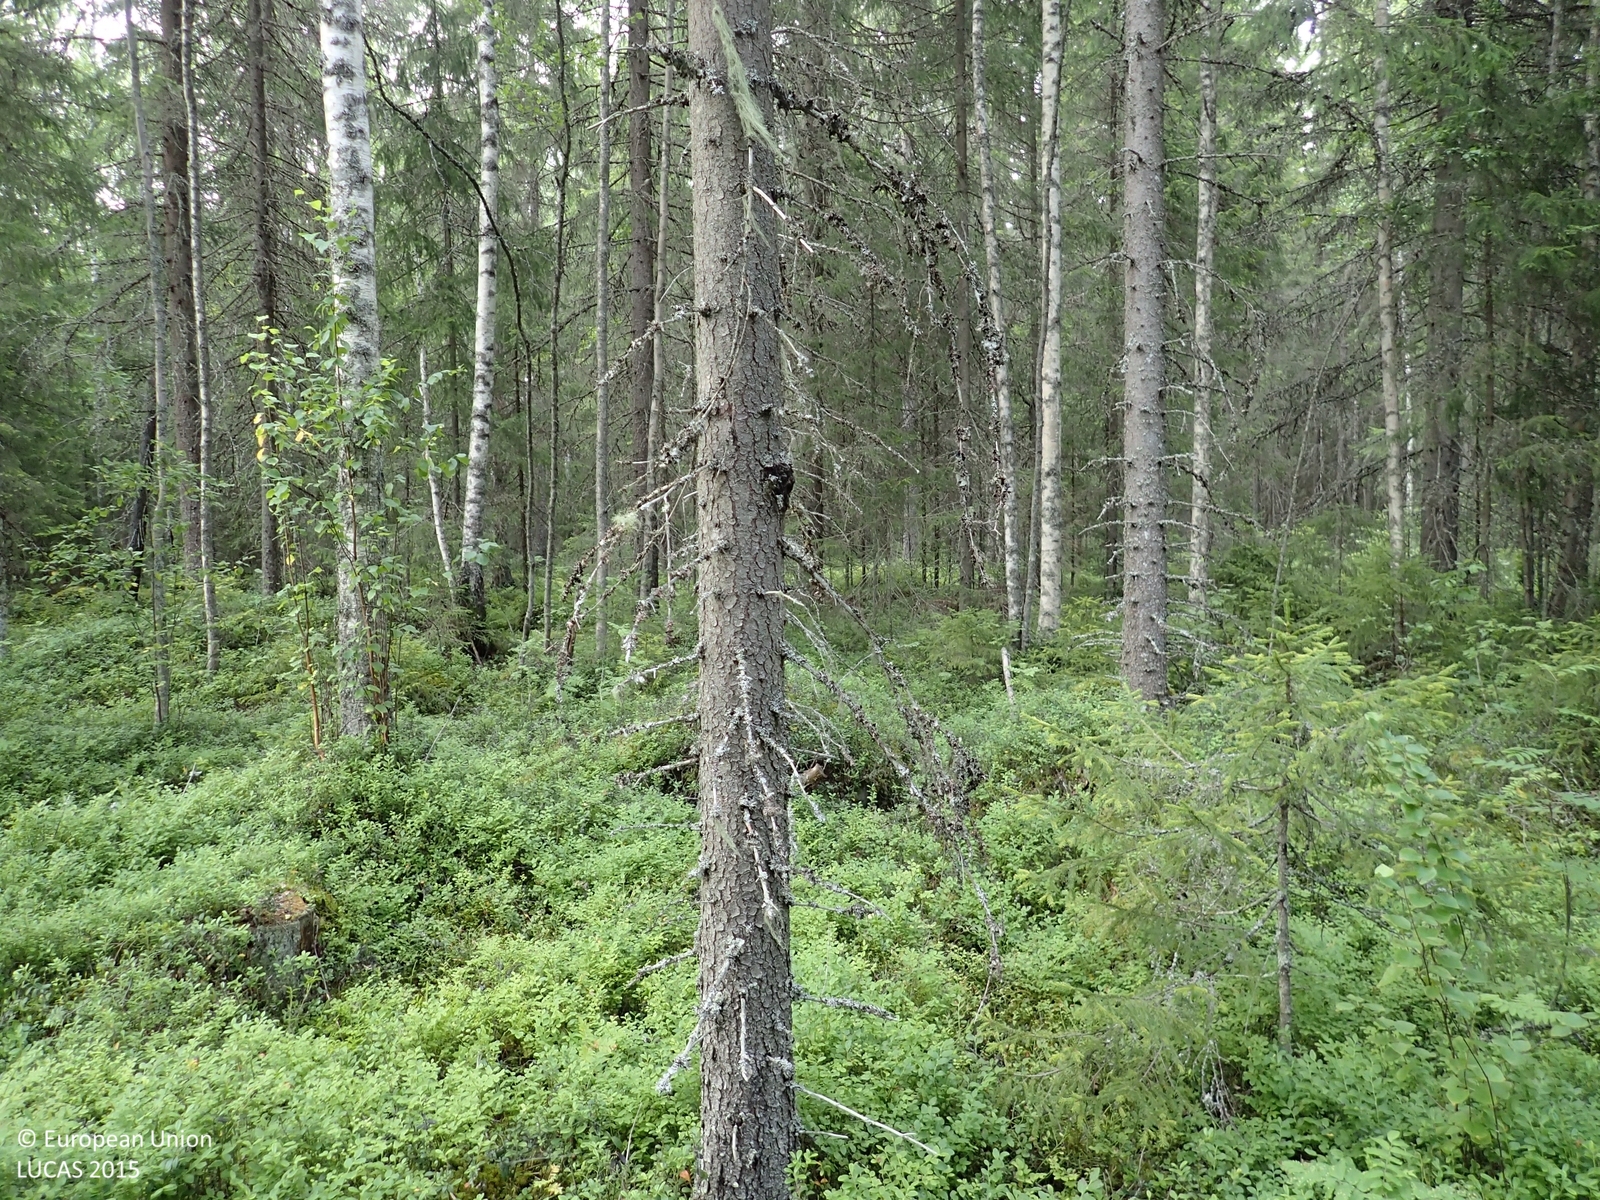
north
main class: Woodland
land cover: Spruce dominated coniferous woodland
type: boreal forest
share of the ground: > 75 %
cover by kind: coniferous forest trees 65 %, shrubs 20 %, broadleaved forest trees 10 %, lichens and mosses 5 %
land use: Forestry
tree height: > 5 m
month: August
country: FI
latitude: 62.7574
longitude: 21.9323
